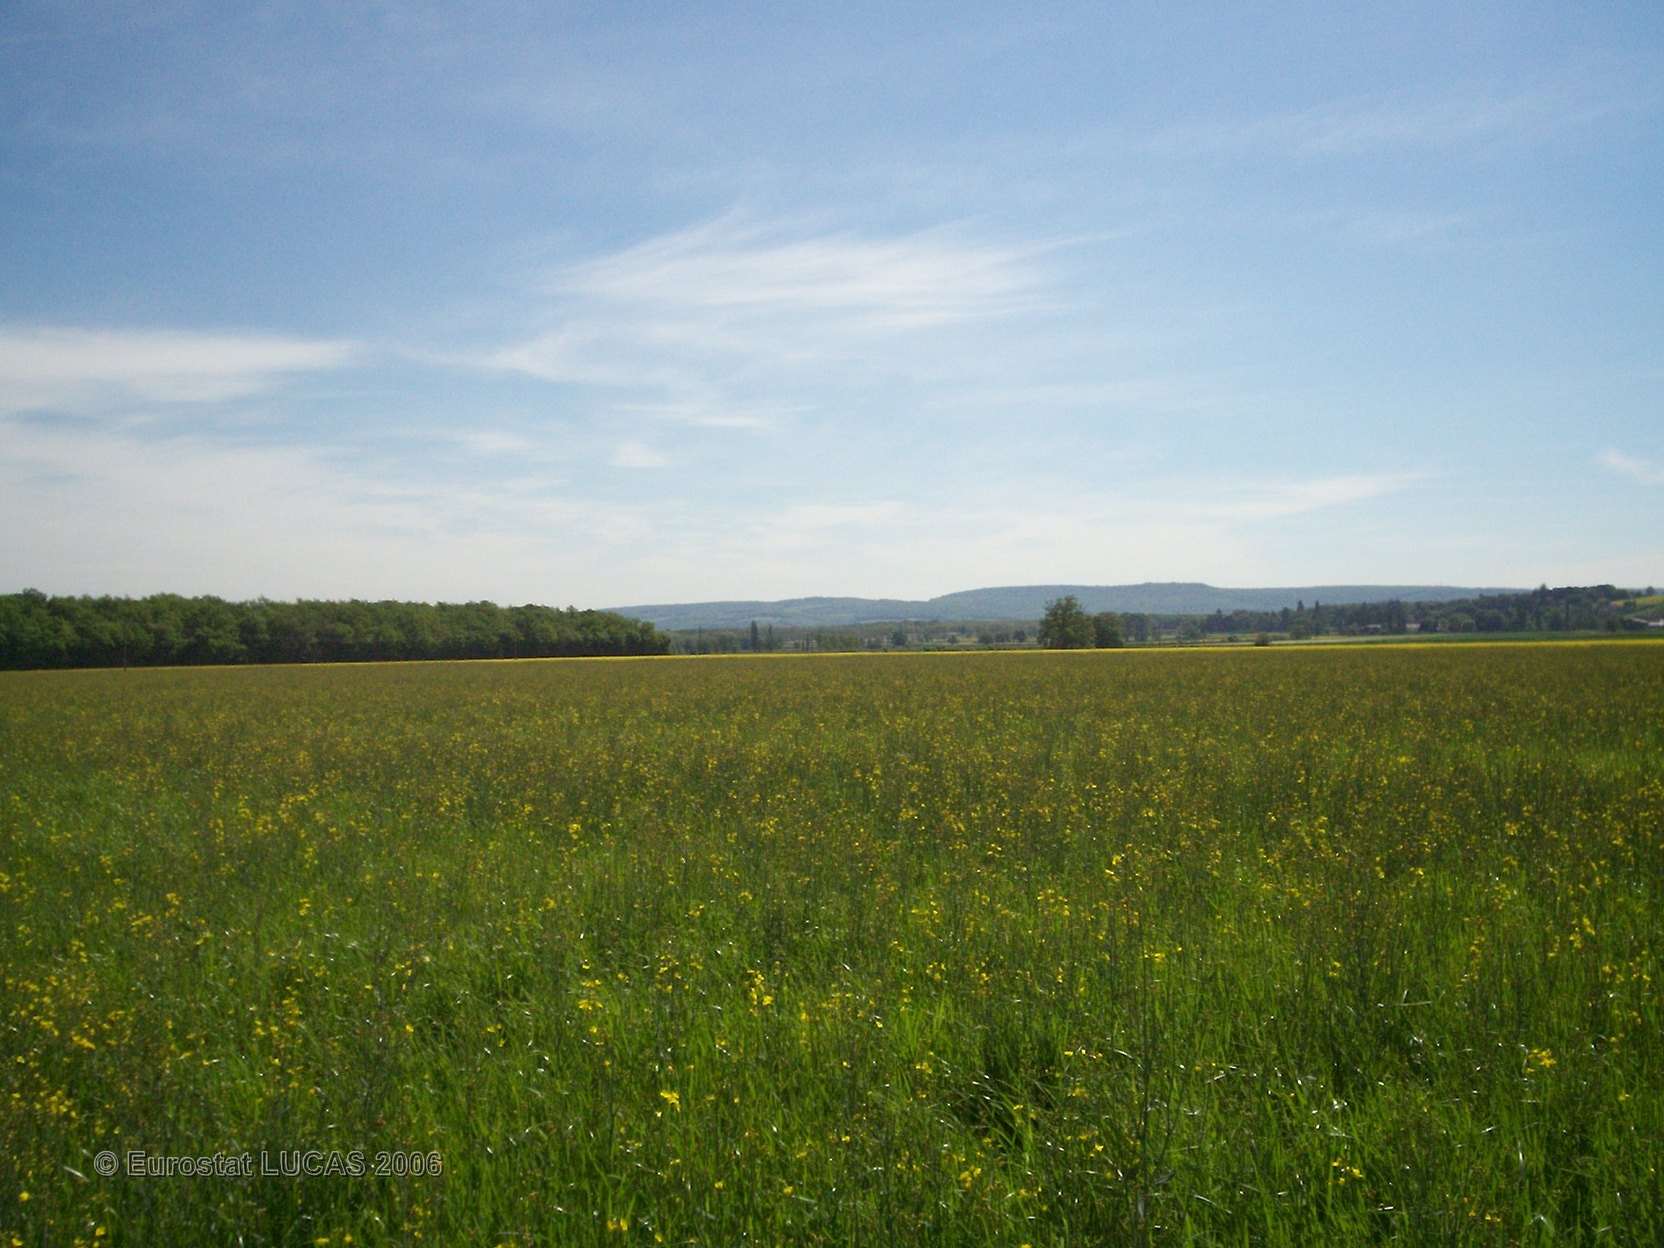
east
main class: Grassland
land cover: Grassland without tree/shrub cover
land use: Agriculture (excluding fallow land and kitchen gardens)
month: May
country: FR
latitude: 46.5996
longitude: 4.7146
